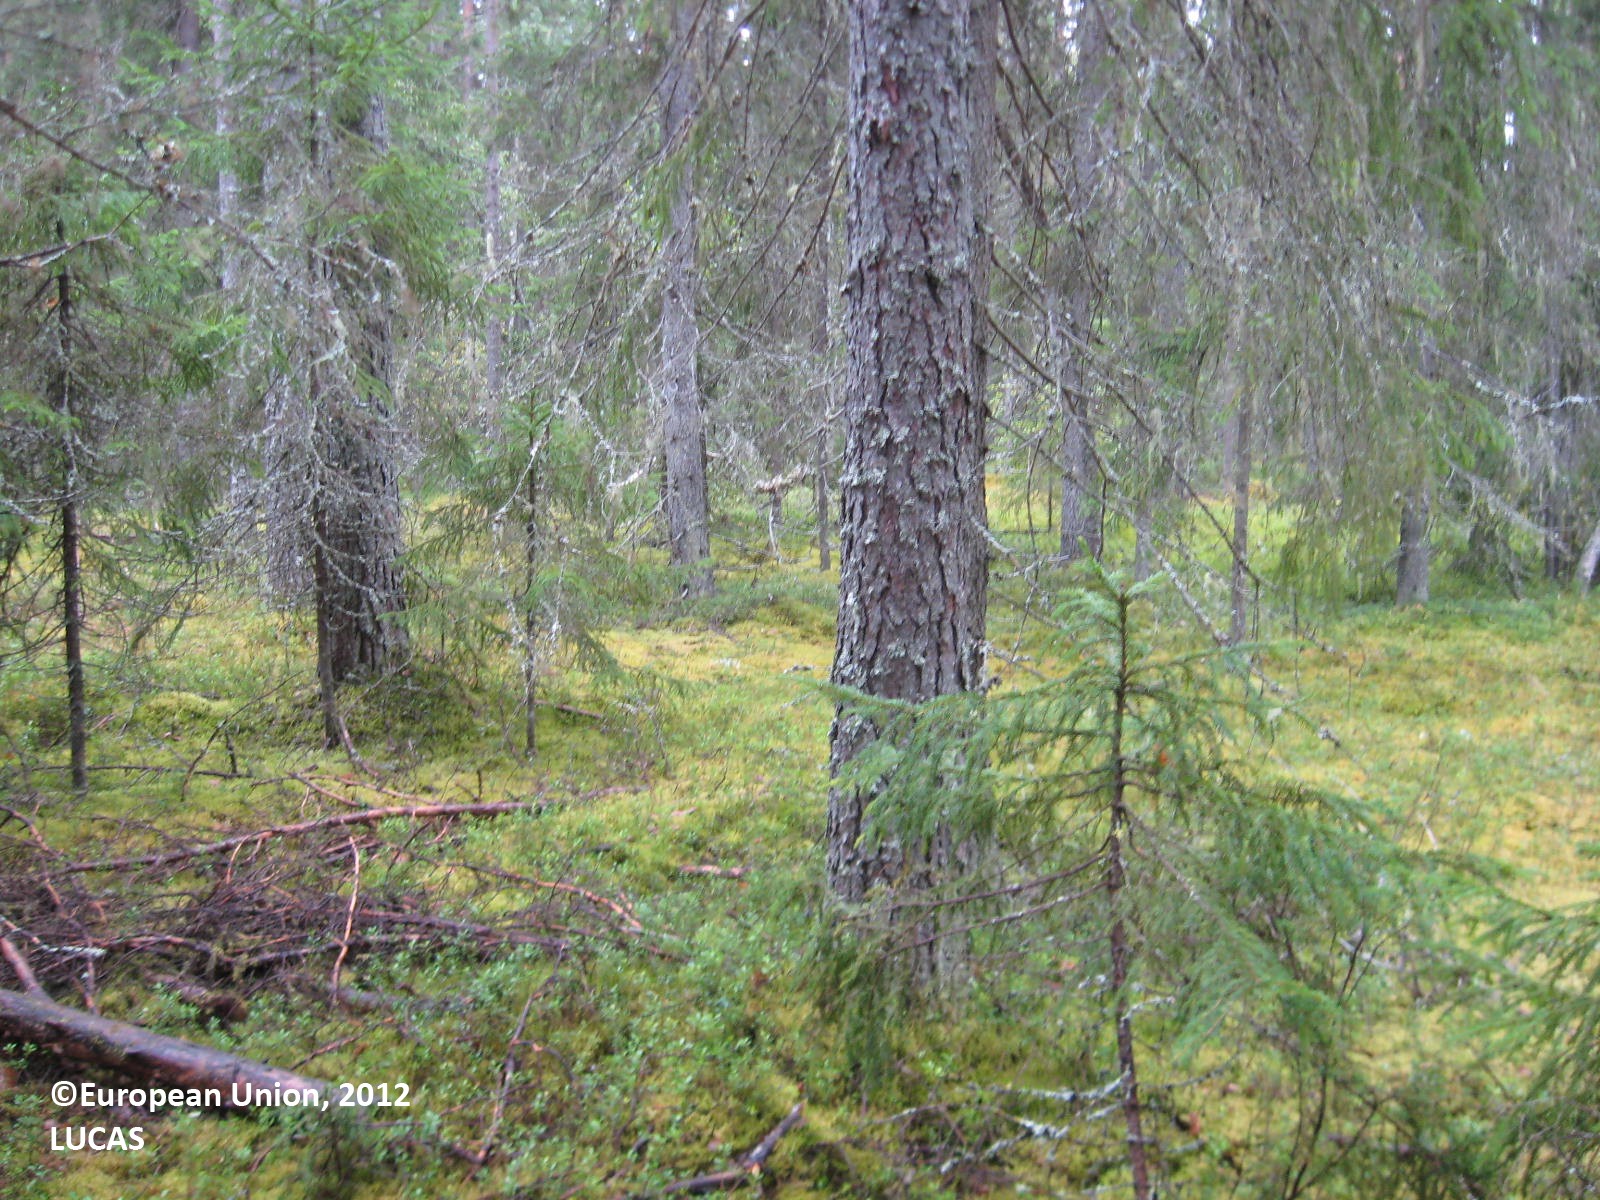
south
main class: Woodland
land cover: Other coniferous woodland
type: boreal forest
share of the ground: > 75 %
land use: Forestry
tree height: > 5 m
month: August
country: FI
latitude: 63.4906
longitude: 29.6101
